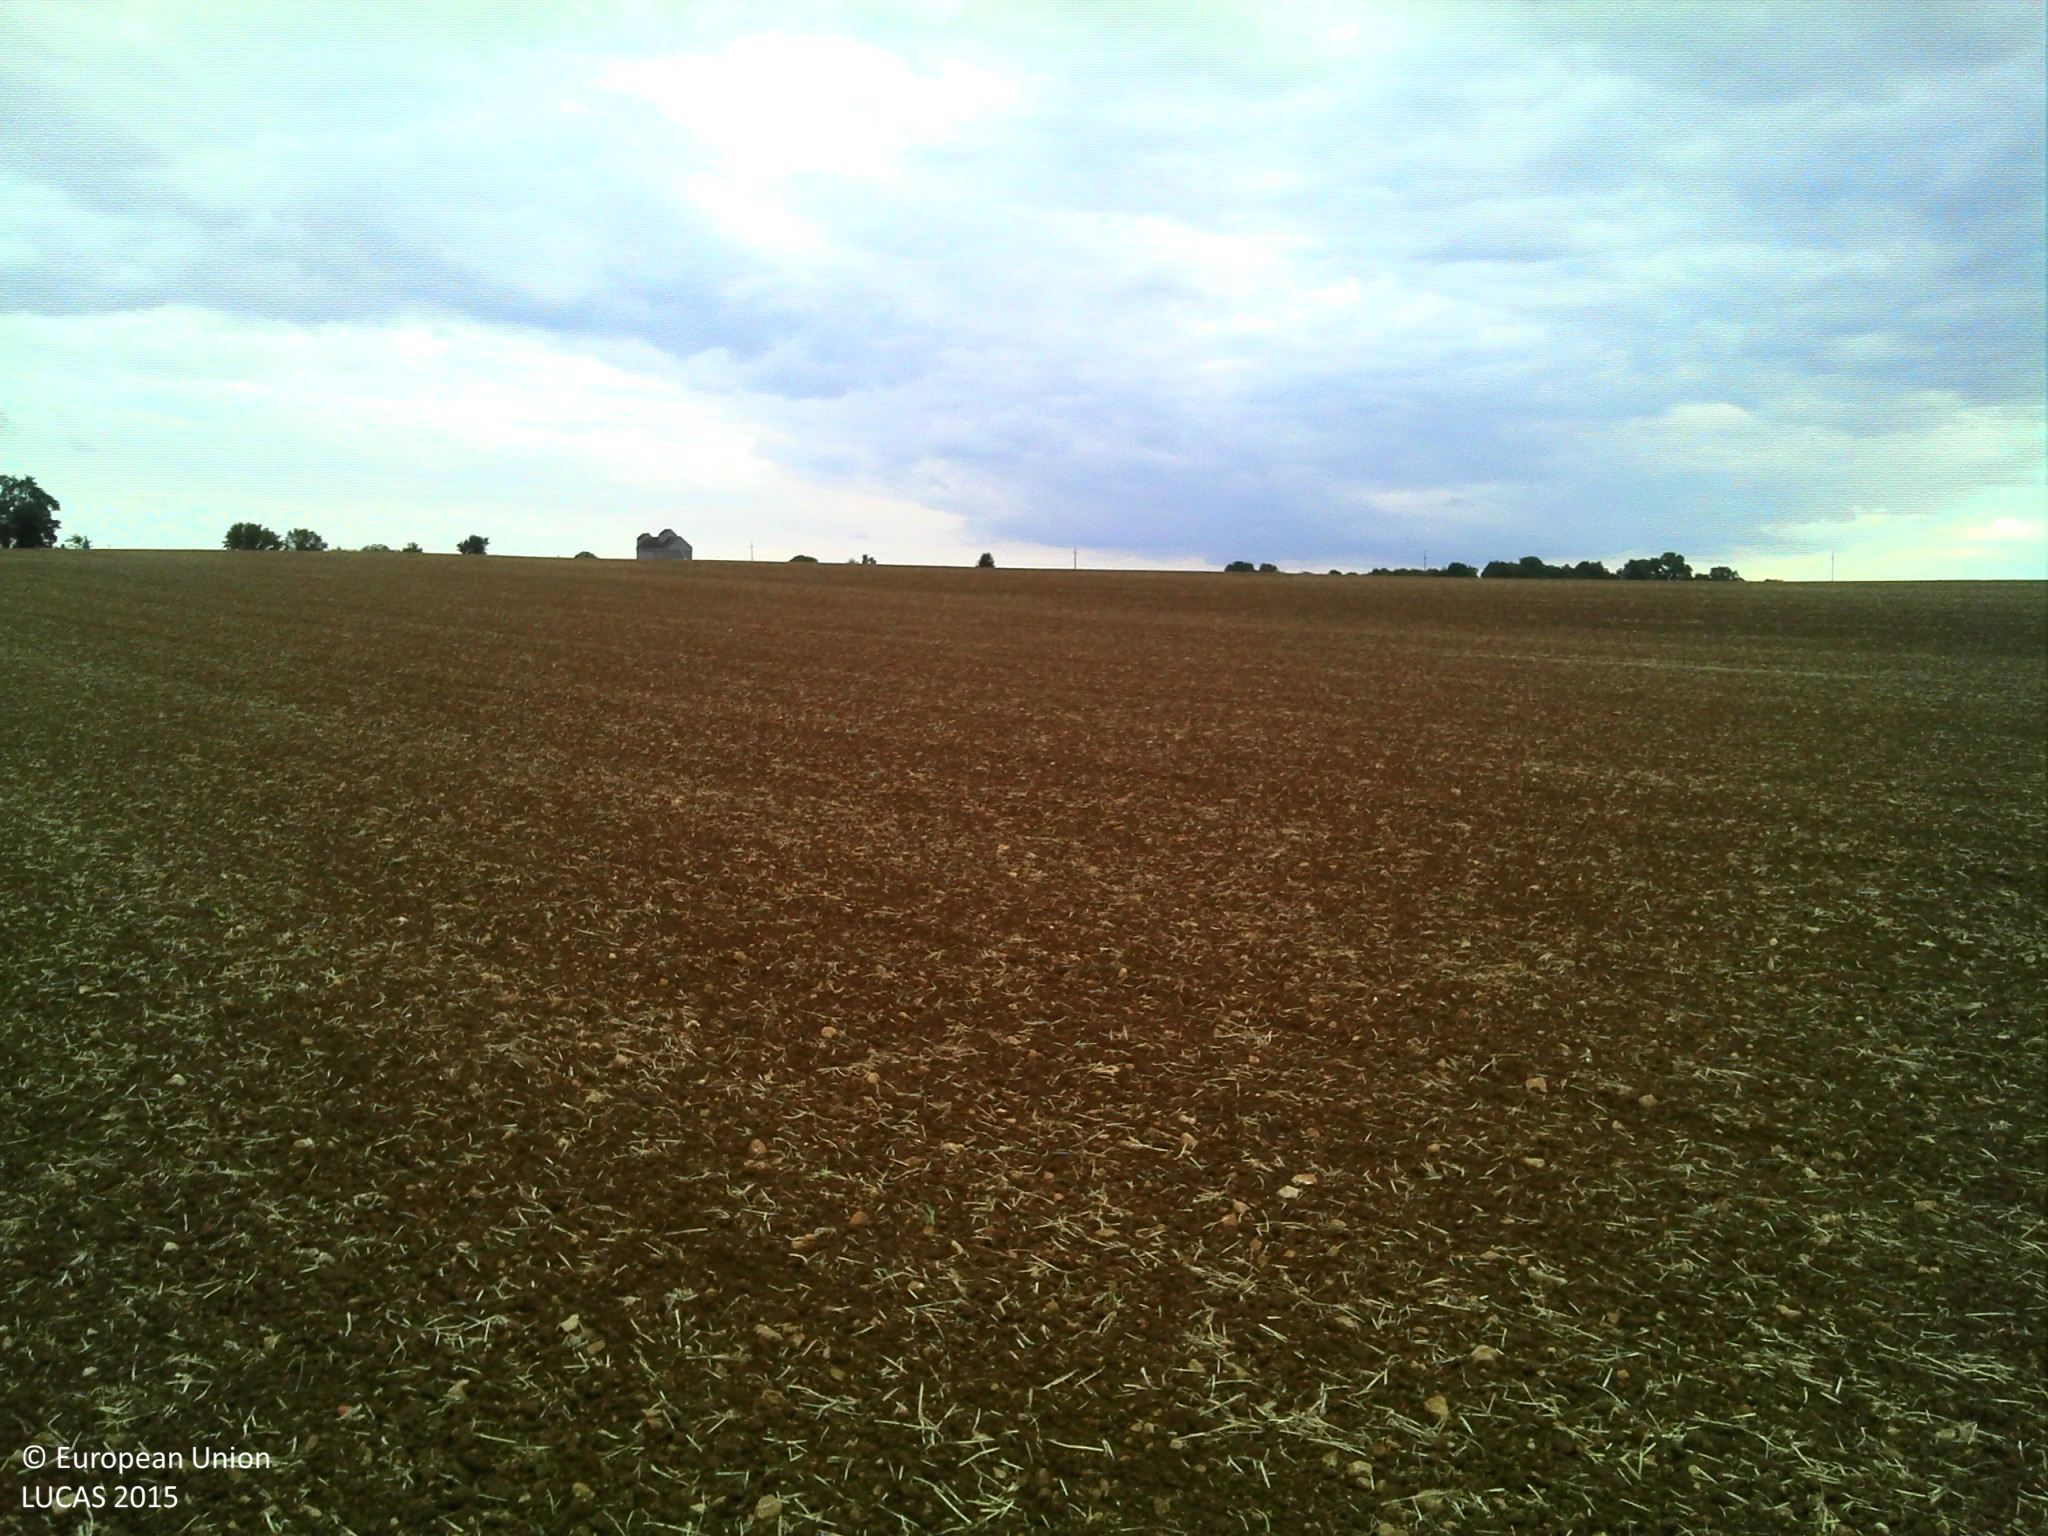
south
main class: Cropland
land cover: Barley
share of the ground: 25 - 50 %
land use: Agriculture (excluding fallow land and kitchen gardens)
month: September
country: FR
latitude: 47.7390
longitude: 4.4107
